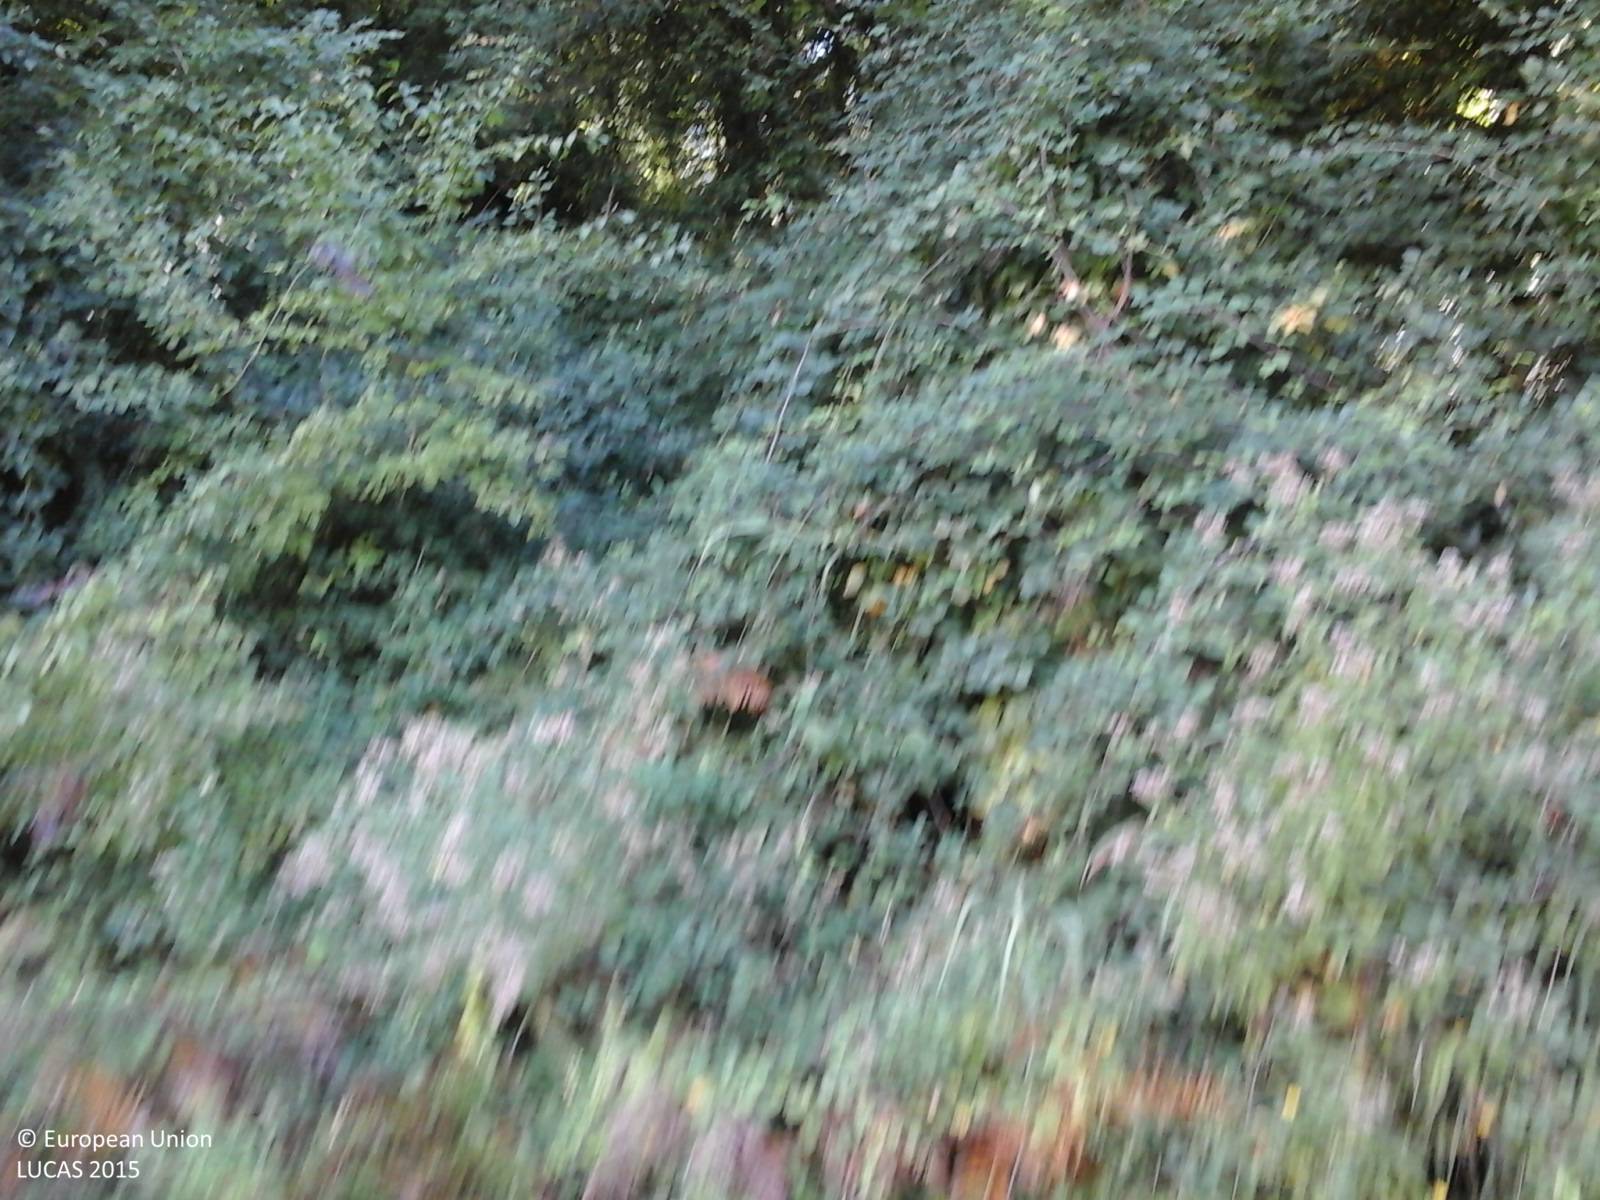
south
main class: Woodland
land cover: Broadleaved woodland
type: thermophilous deciduous forest
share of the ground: > 75 %
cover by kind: broadleaved forest trees 100 %
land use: Semi-natural and natural areas not in use
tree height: > 5 m
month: September
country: IT
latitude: 42.3502
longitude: 12.5770
